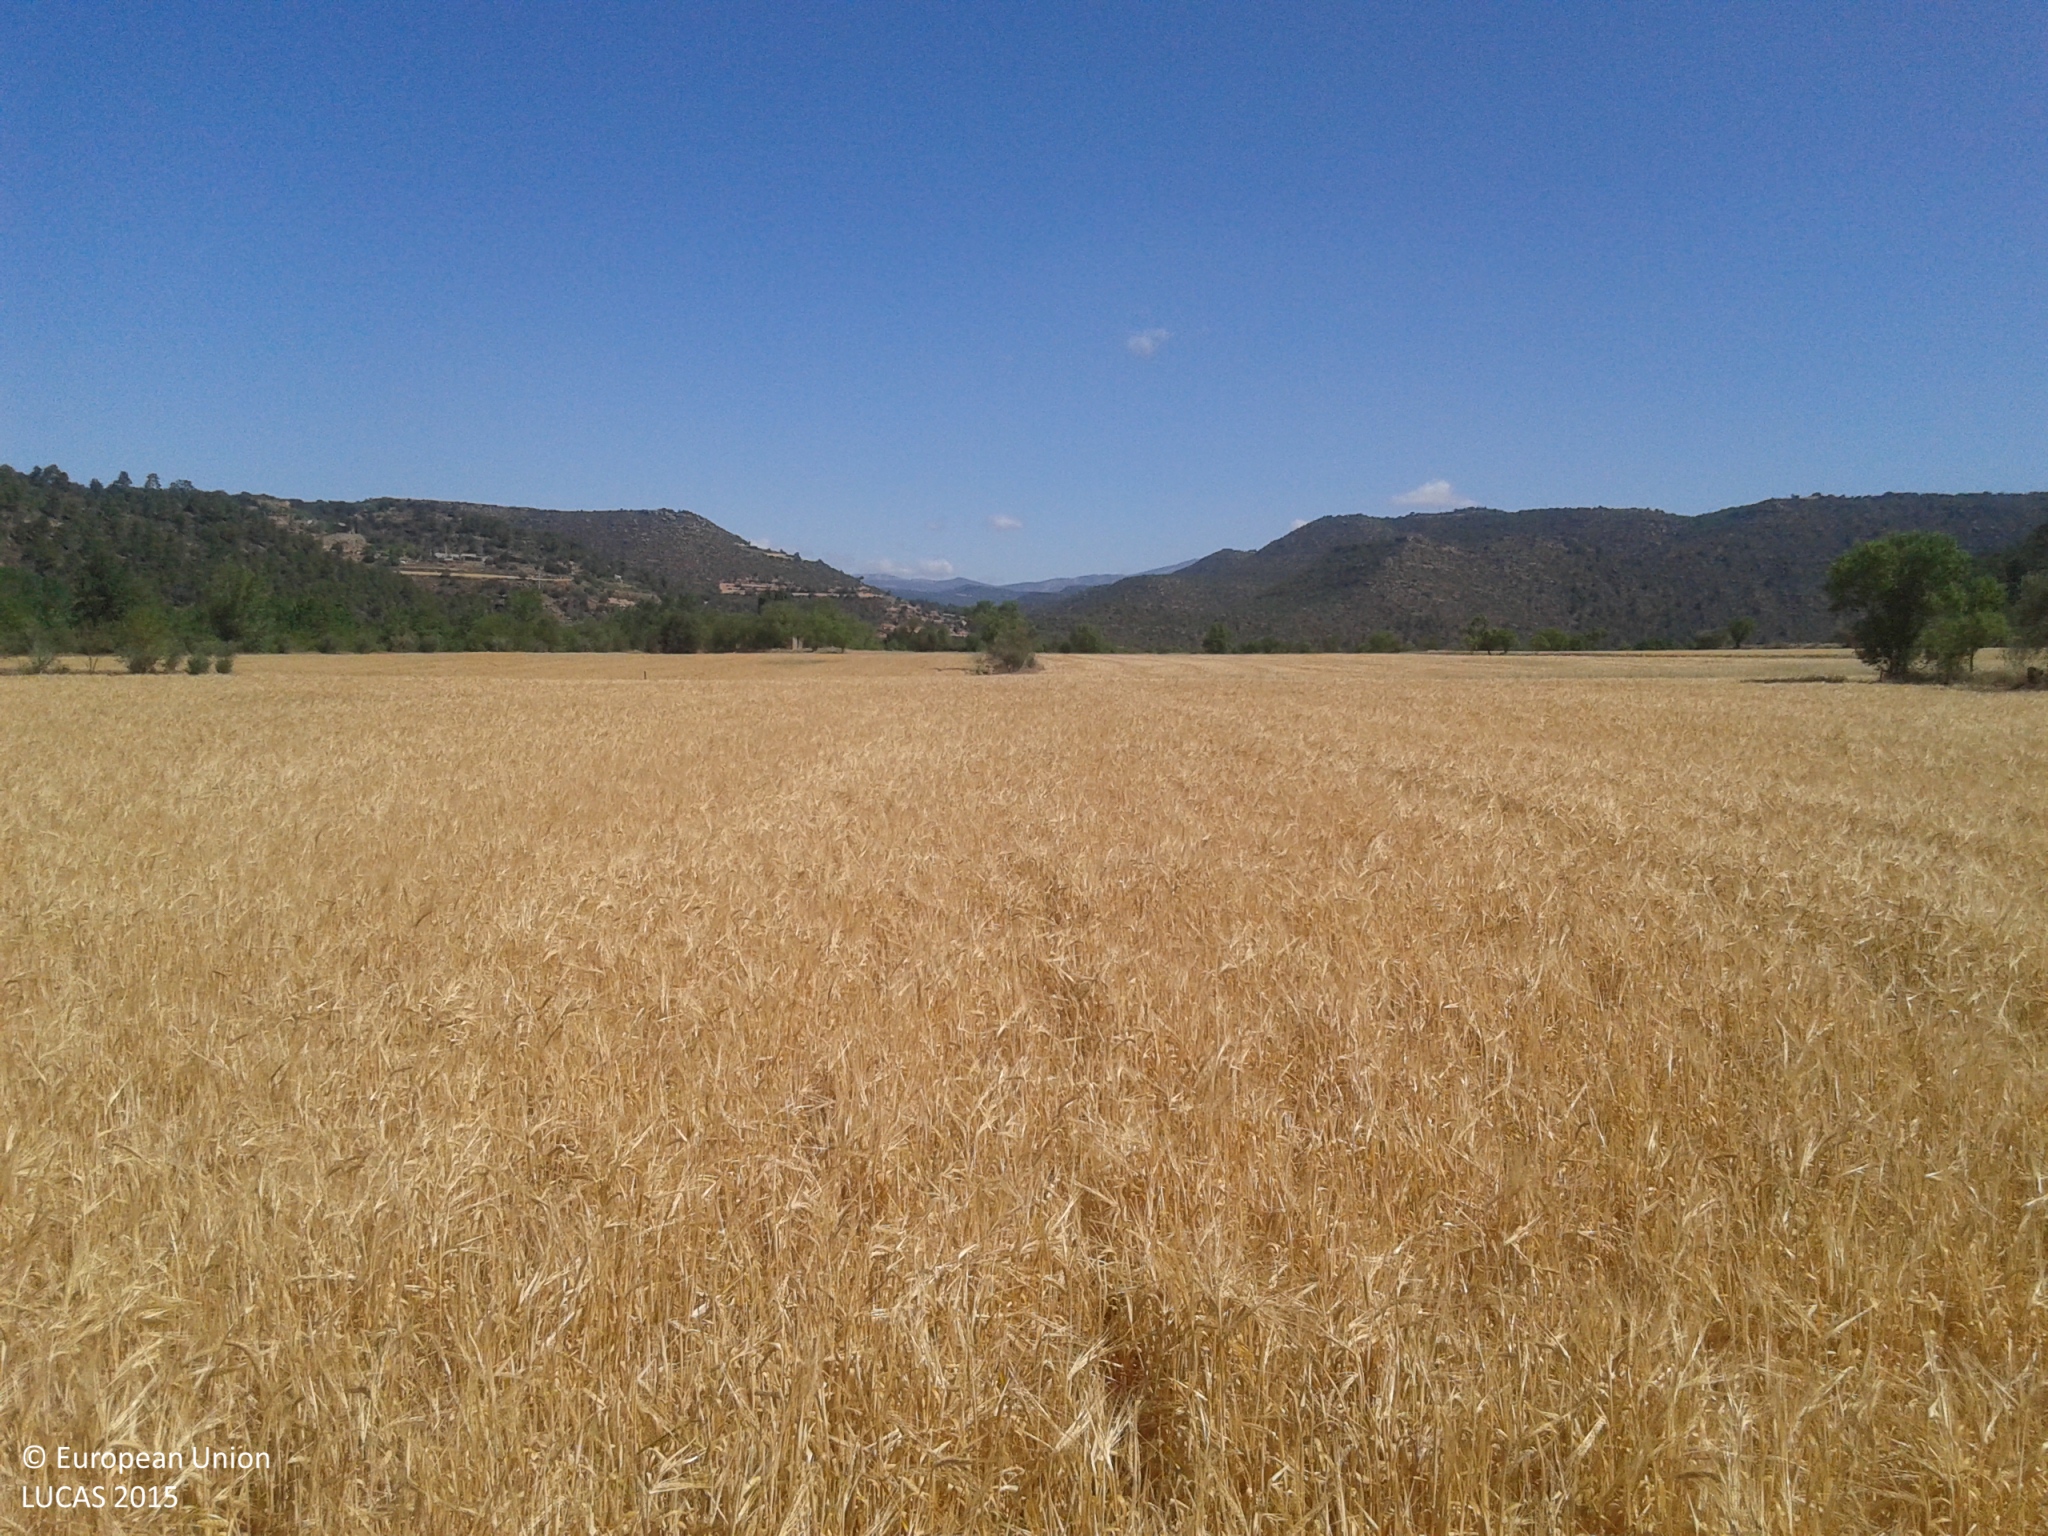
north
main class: Cropland
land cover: Rye
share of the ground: > 75 %
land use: Agriculture (excluding fallow land and kitchen gardens)
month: May
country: ES
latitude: 41.9209
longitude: 1.1492
